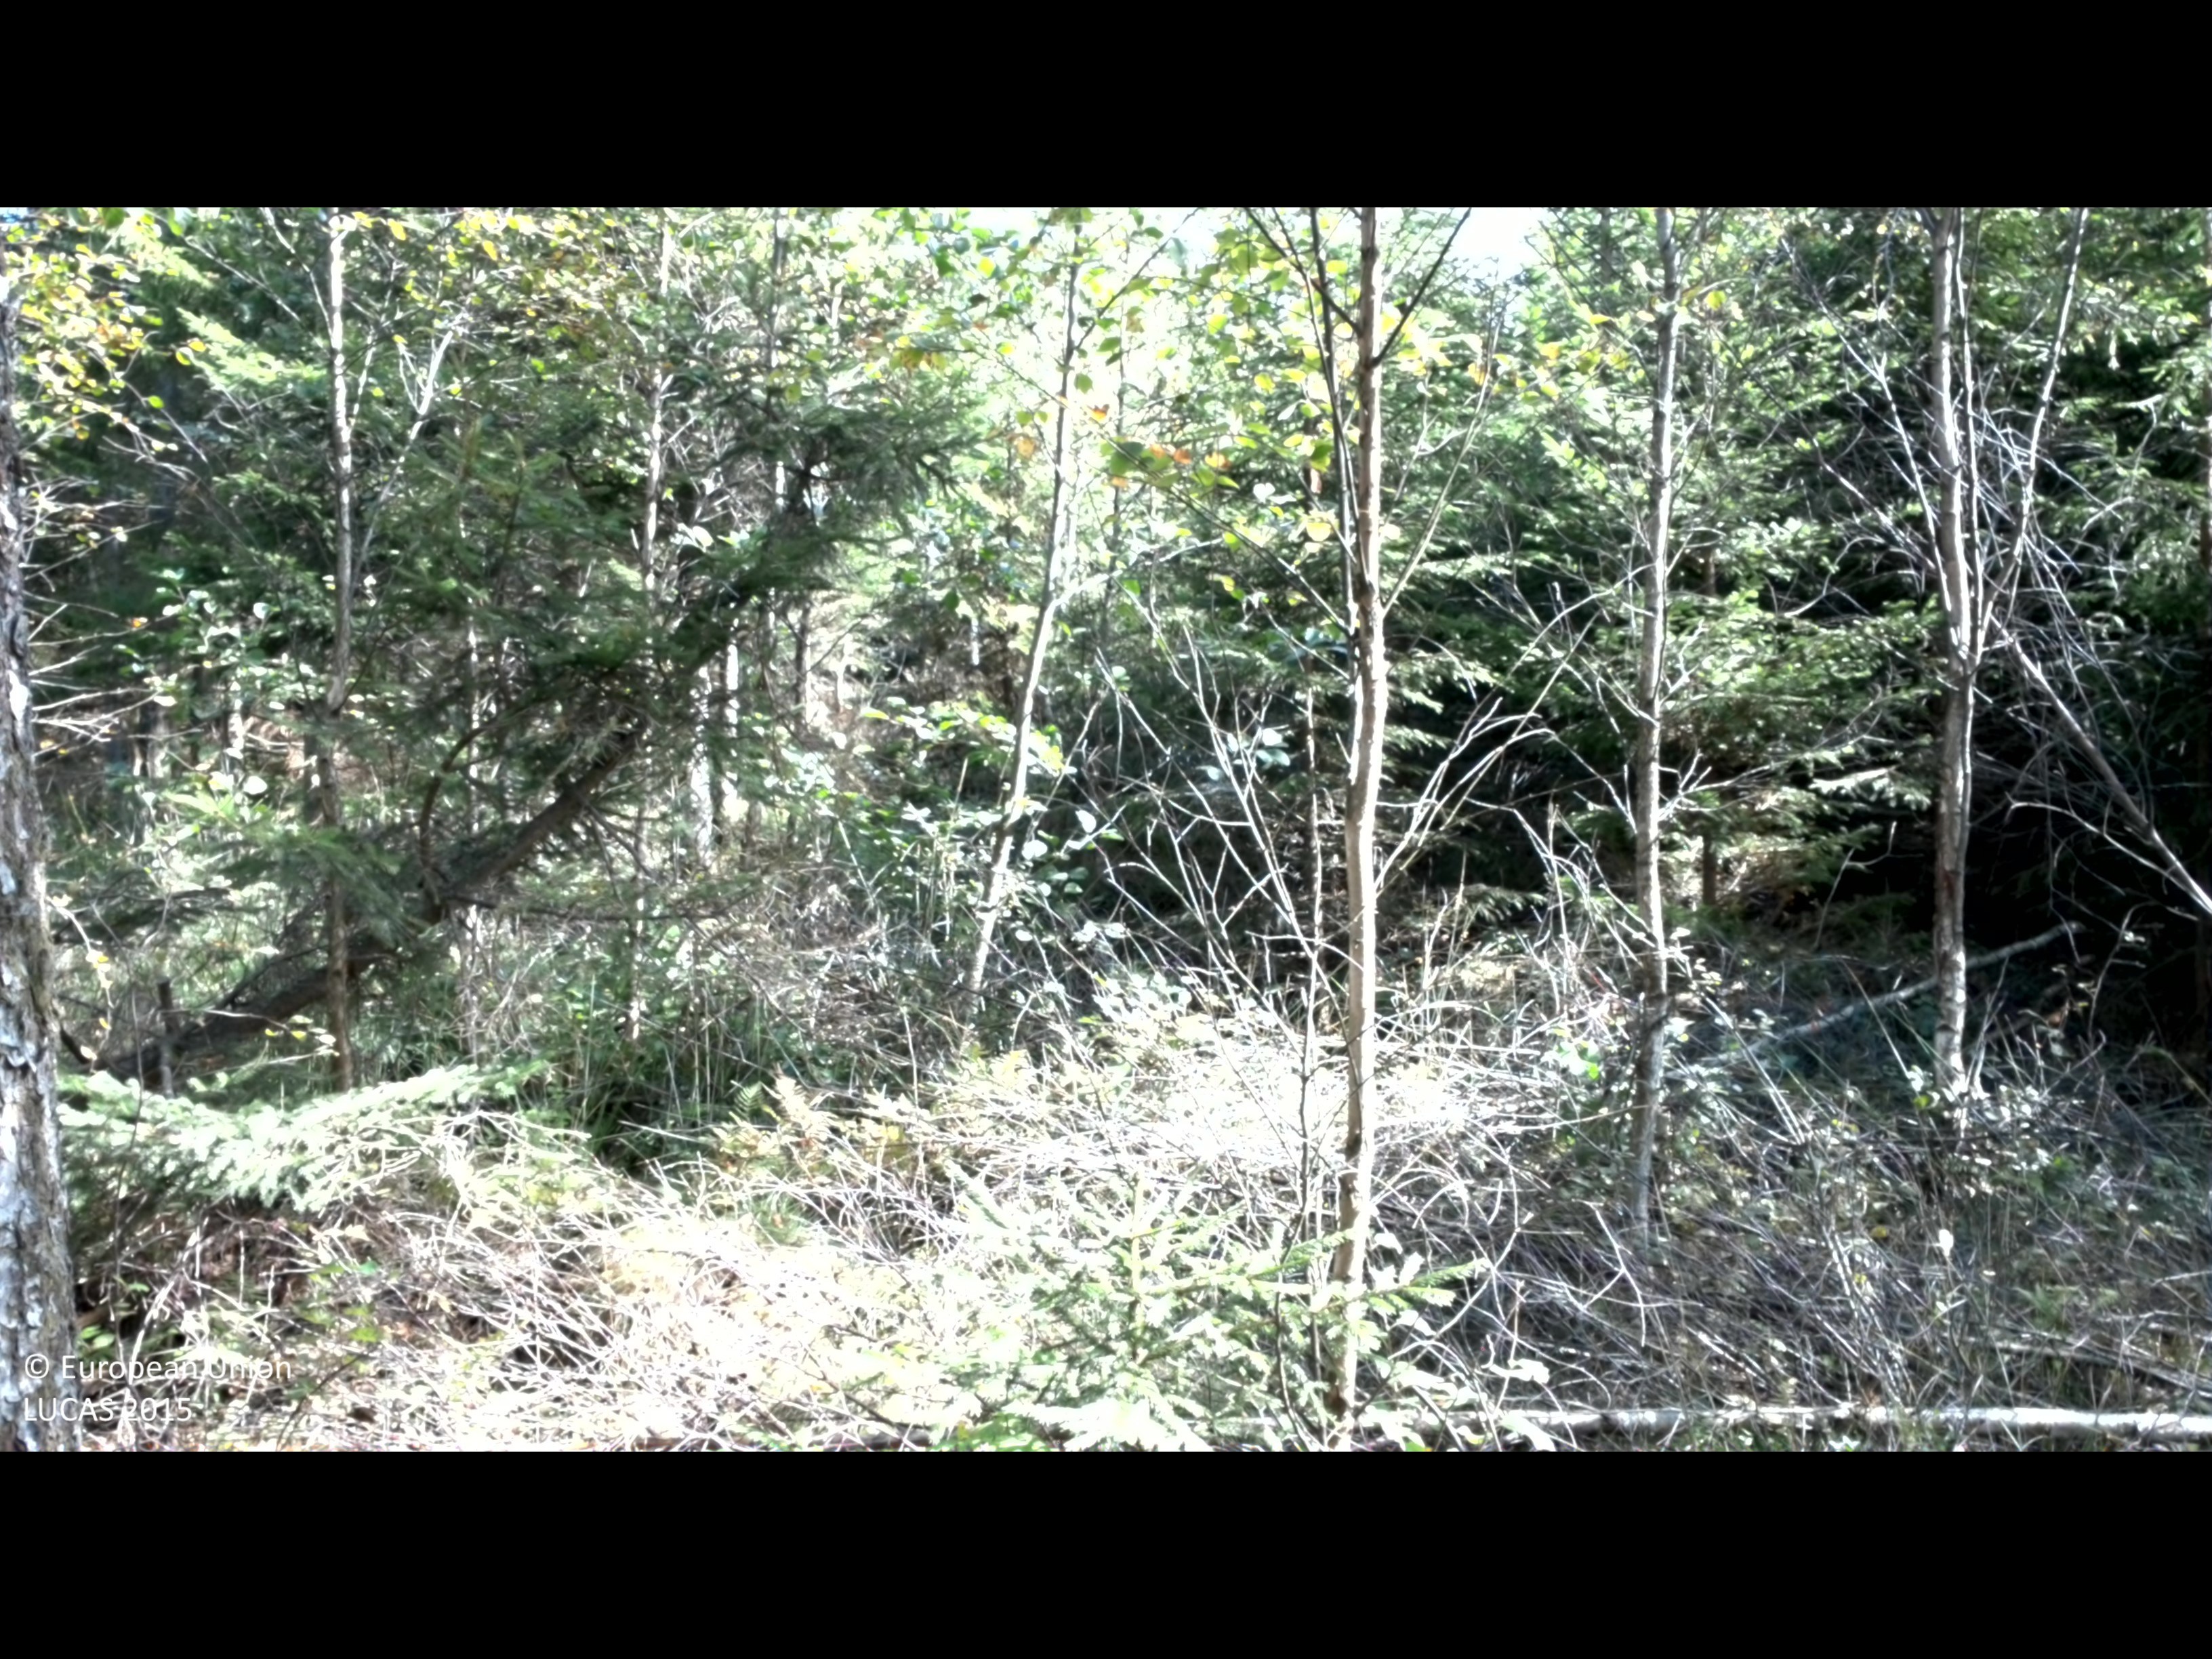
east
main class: Woodland
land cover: Spruce dominated mixed woodland
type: boreal forest
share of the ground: > 75 %
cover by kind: broadleaved forest trees 45 %, coniferous forest trees 35 %, shrubs 10 %, herbaceous plants 5 %, lichens and mosses 5 %
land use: Forestry
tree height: > 5 m
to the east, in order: Spruce dominated mixed woodland; Spruce dominated coniferous woodland; Tracks; Spruce dominated coniferous woodland; Paved roads, cycling and walking lanes; Spruce dominated mixed woodland; Ditches and canals; Spruce dominated mixed woodland; Ditches and canals; Spruce dominated mixed woodland
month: September
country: SE
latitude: 57.0130
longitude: 13.1418
